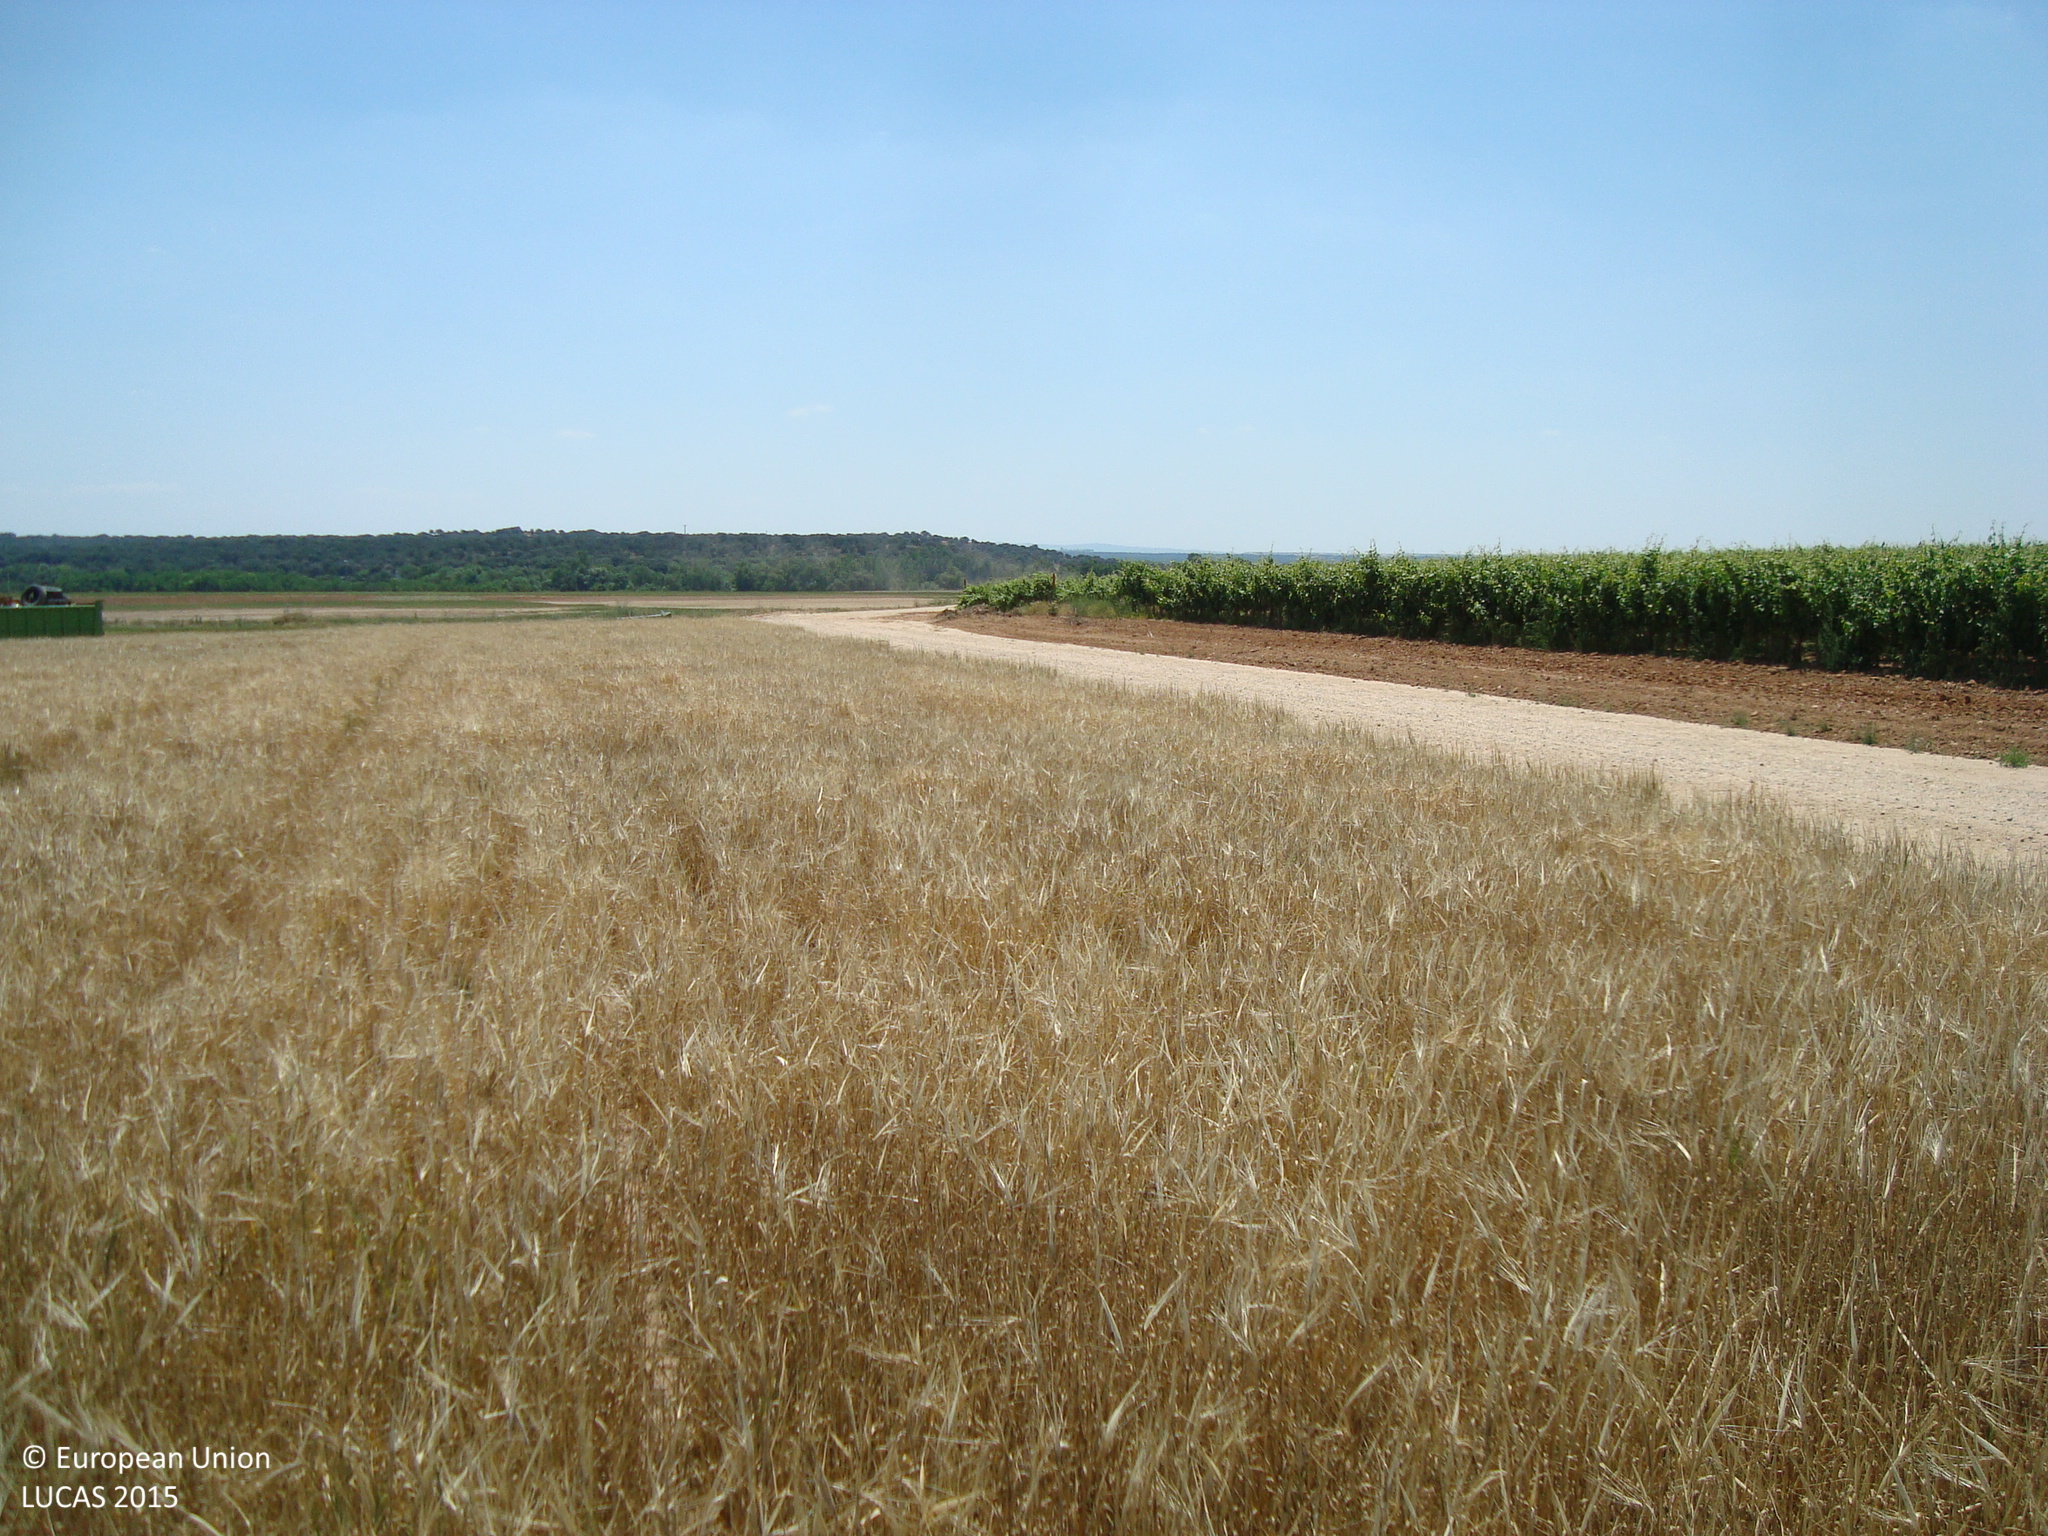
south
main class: Cropland
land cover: Barley
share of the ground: > 75 %
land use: Agriculture (excluding fallow land and kitchen gardens)
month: June
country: ES
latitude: 41.7167
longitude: -3.8421
